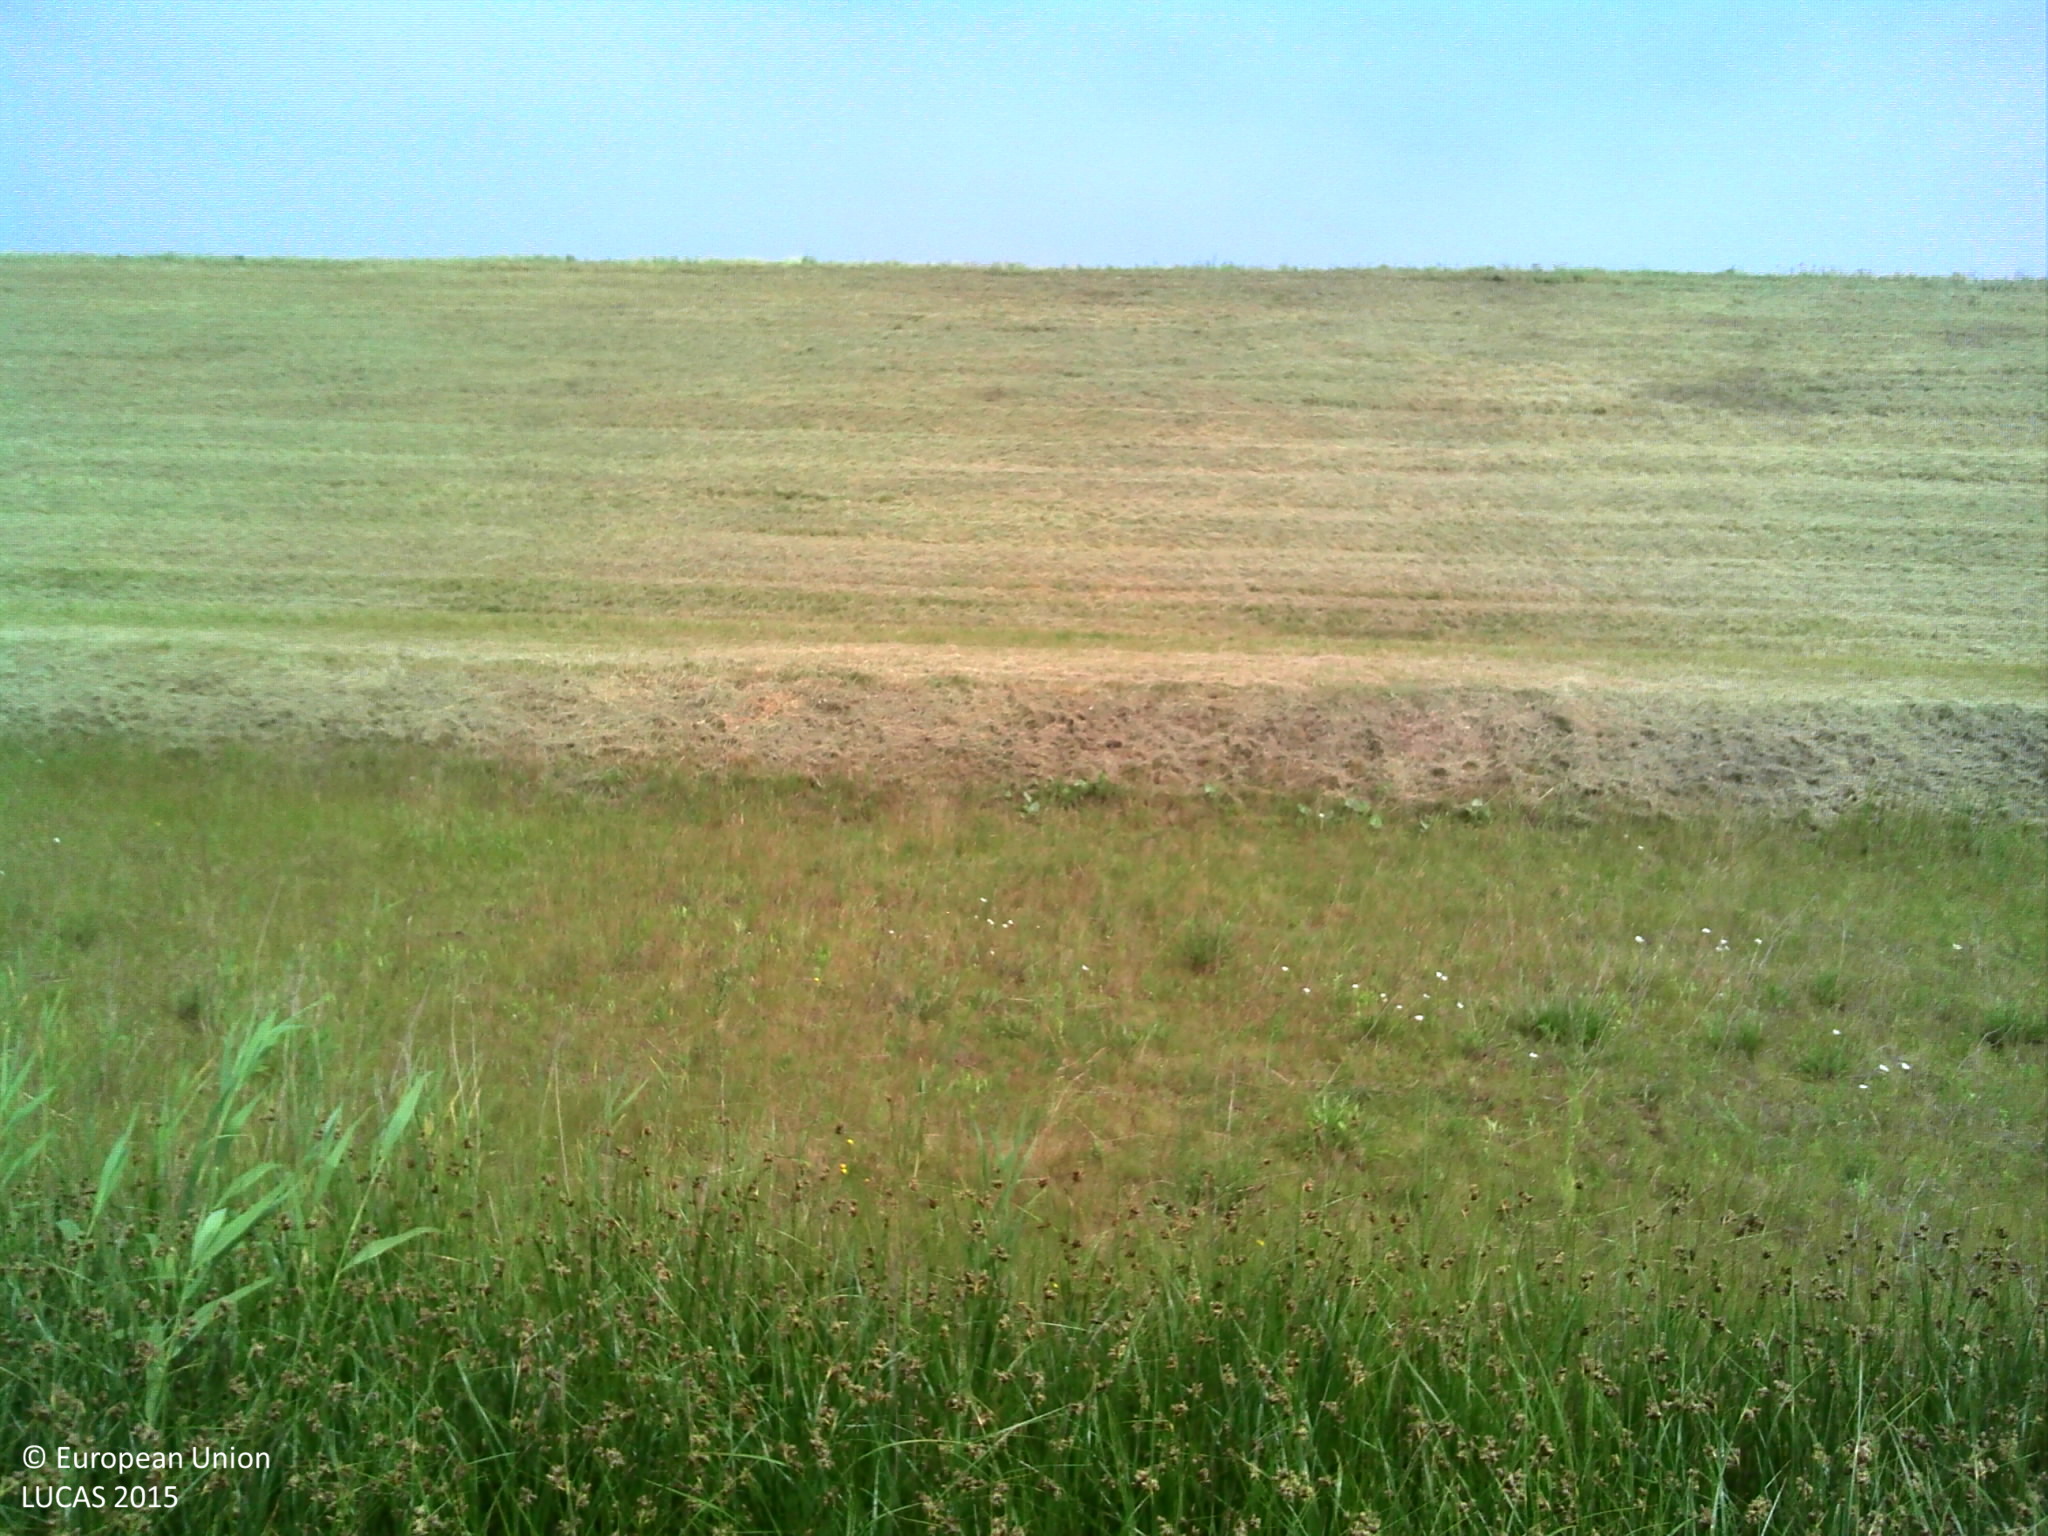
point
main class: Grassland
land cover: Spontaneously vegetated surfaces
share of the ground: > 75 %
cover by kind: herbaceous plants 100 %
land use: Semi-natural and natural areas not in use
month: June
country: BE
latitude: 51.3365
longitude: 4.2390
